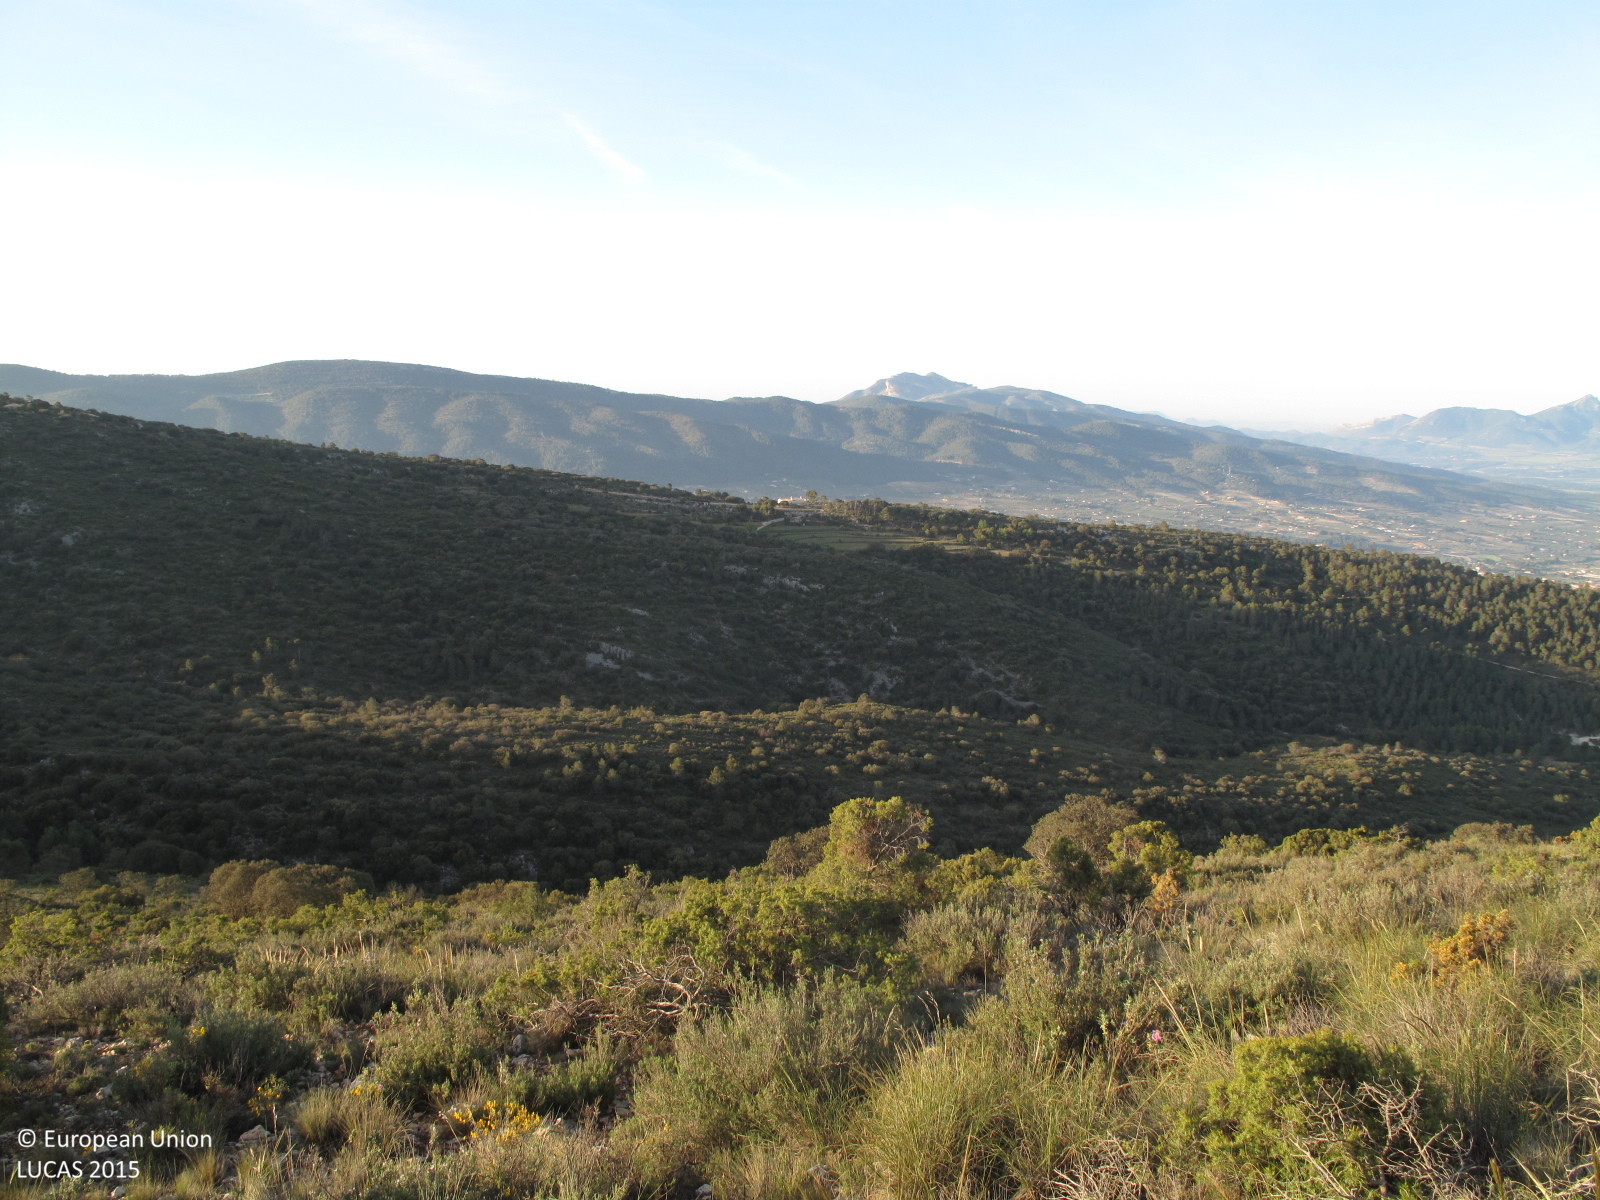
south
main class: Shrubland
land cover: Shrubland with sparse tree cover
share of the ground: 10 - 25 %
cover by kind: herbaceous plants 50 %, consolidated bare surface 25 %, shrubs 20 %, coniferous forest trees 5 %
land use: Semi-natural and natural areas not in use
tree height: < 5 m
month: May
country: ES
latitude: 38.6570
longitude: -0.5498
